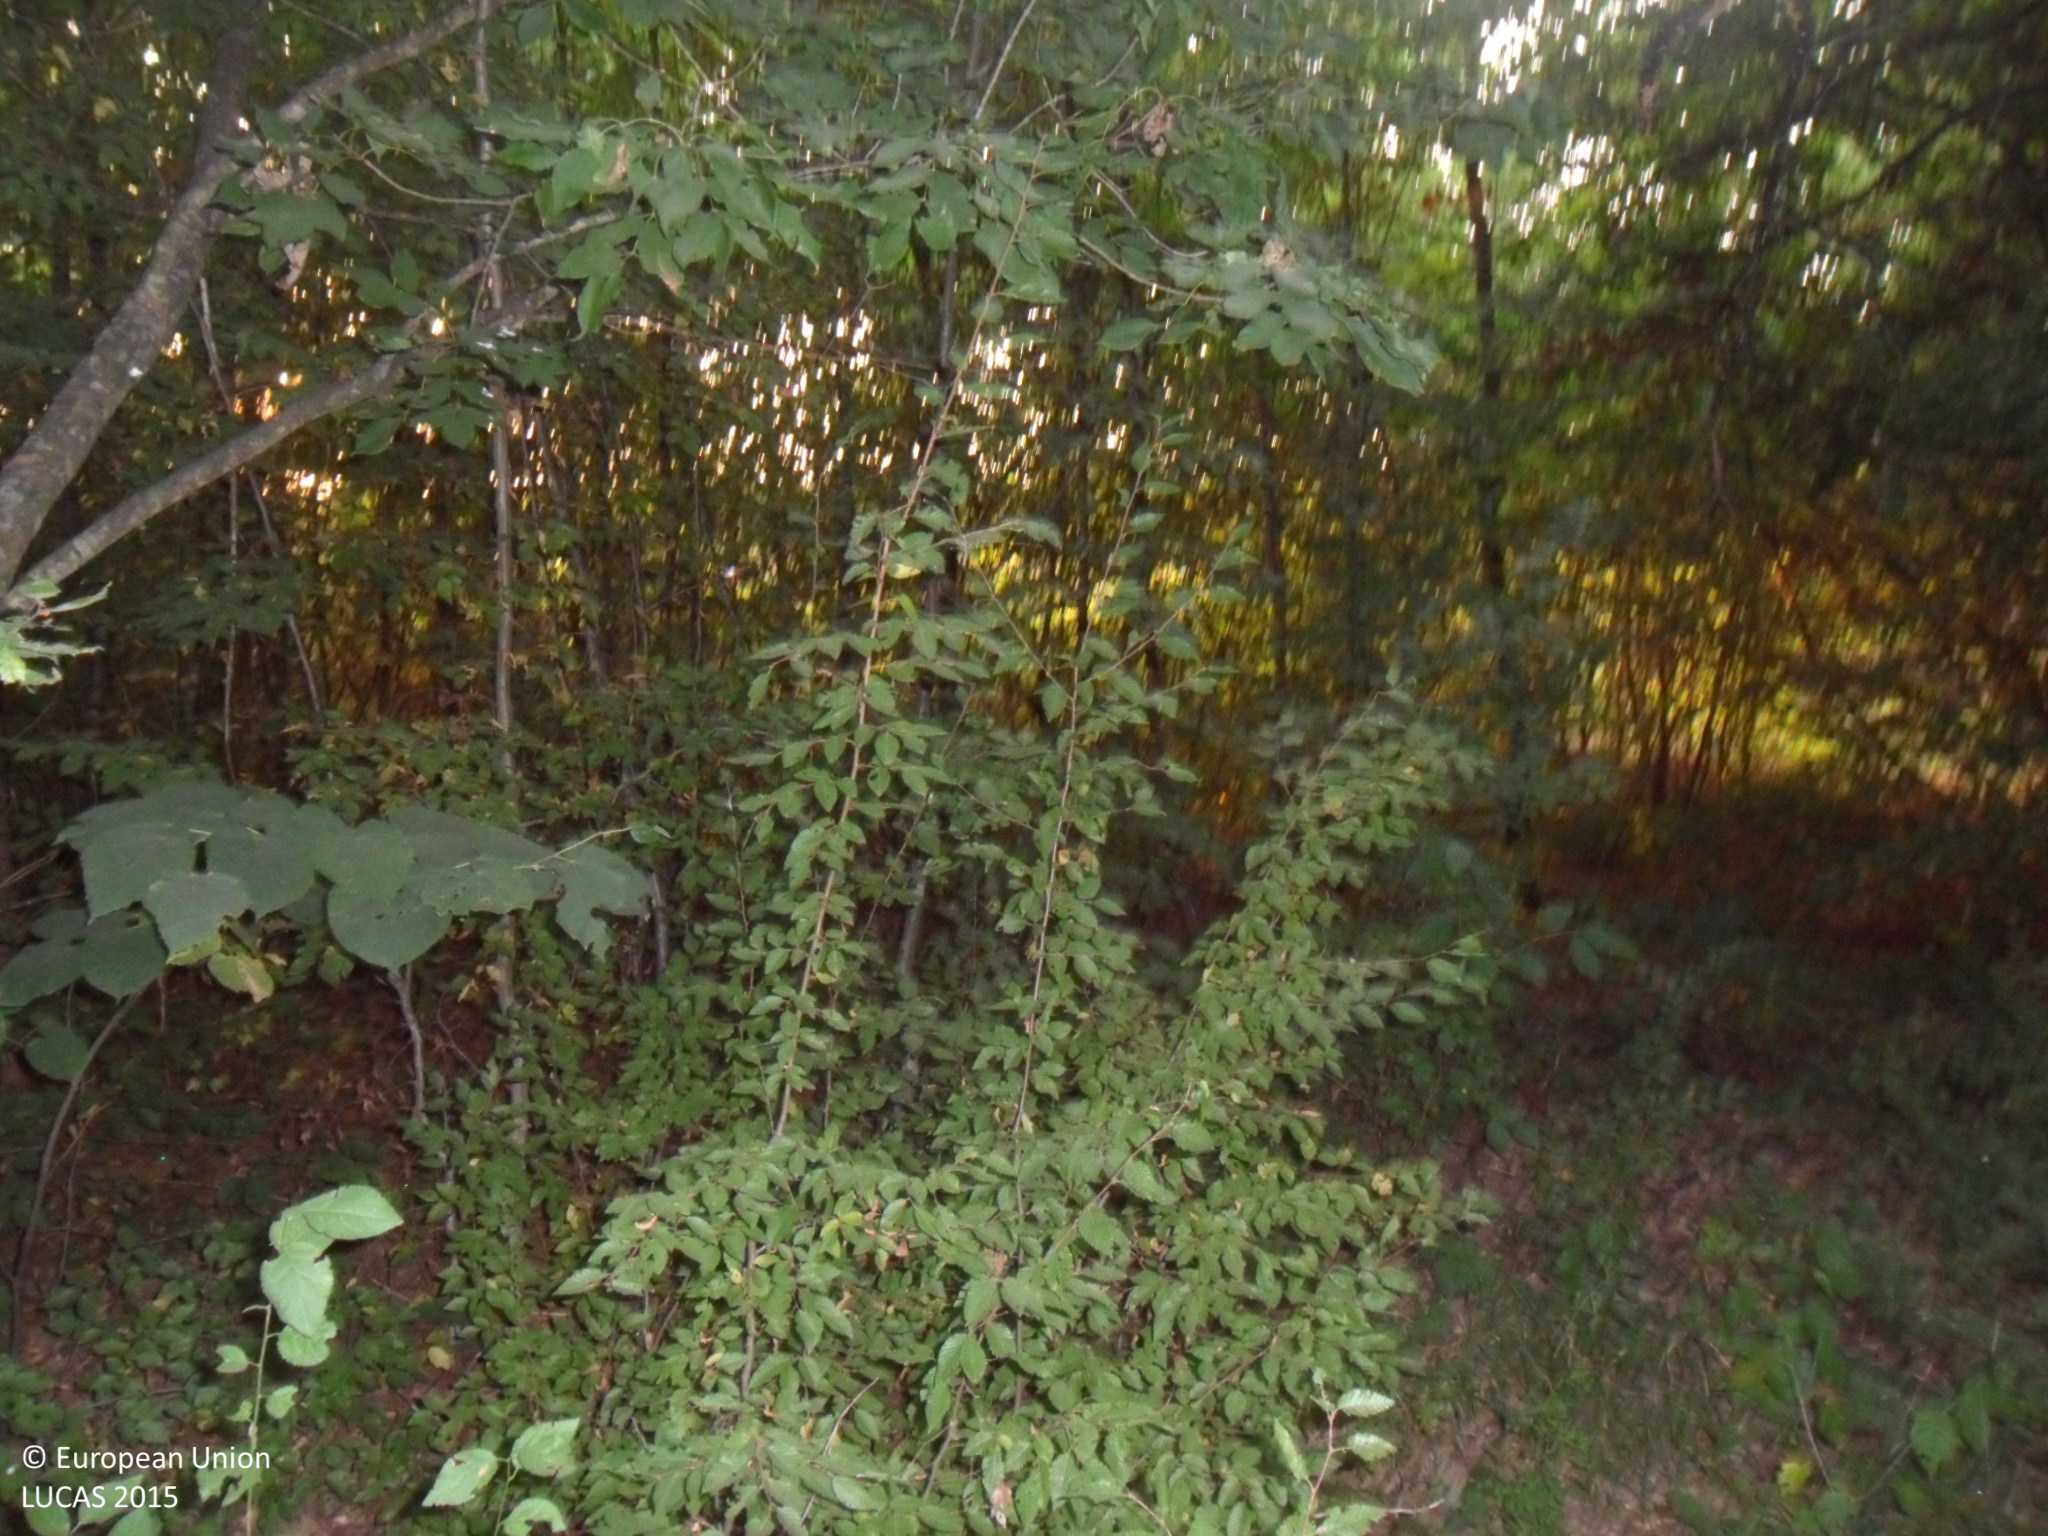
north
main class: Woodland
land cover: Broadleaved woodland
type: mesophytic deciduous forest
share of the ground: > 75 %
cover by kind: broadleaved forest trees 100 %
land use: Forestry
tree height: > 5 m
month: September
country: BG
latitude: 43.6504
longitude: 26.2300
